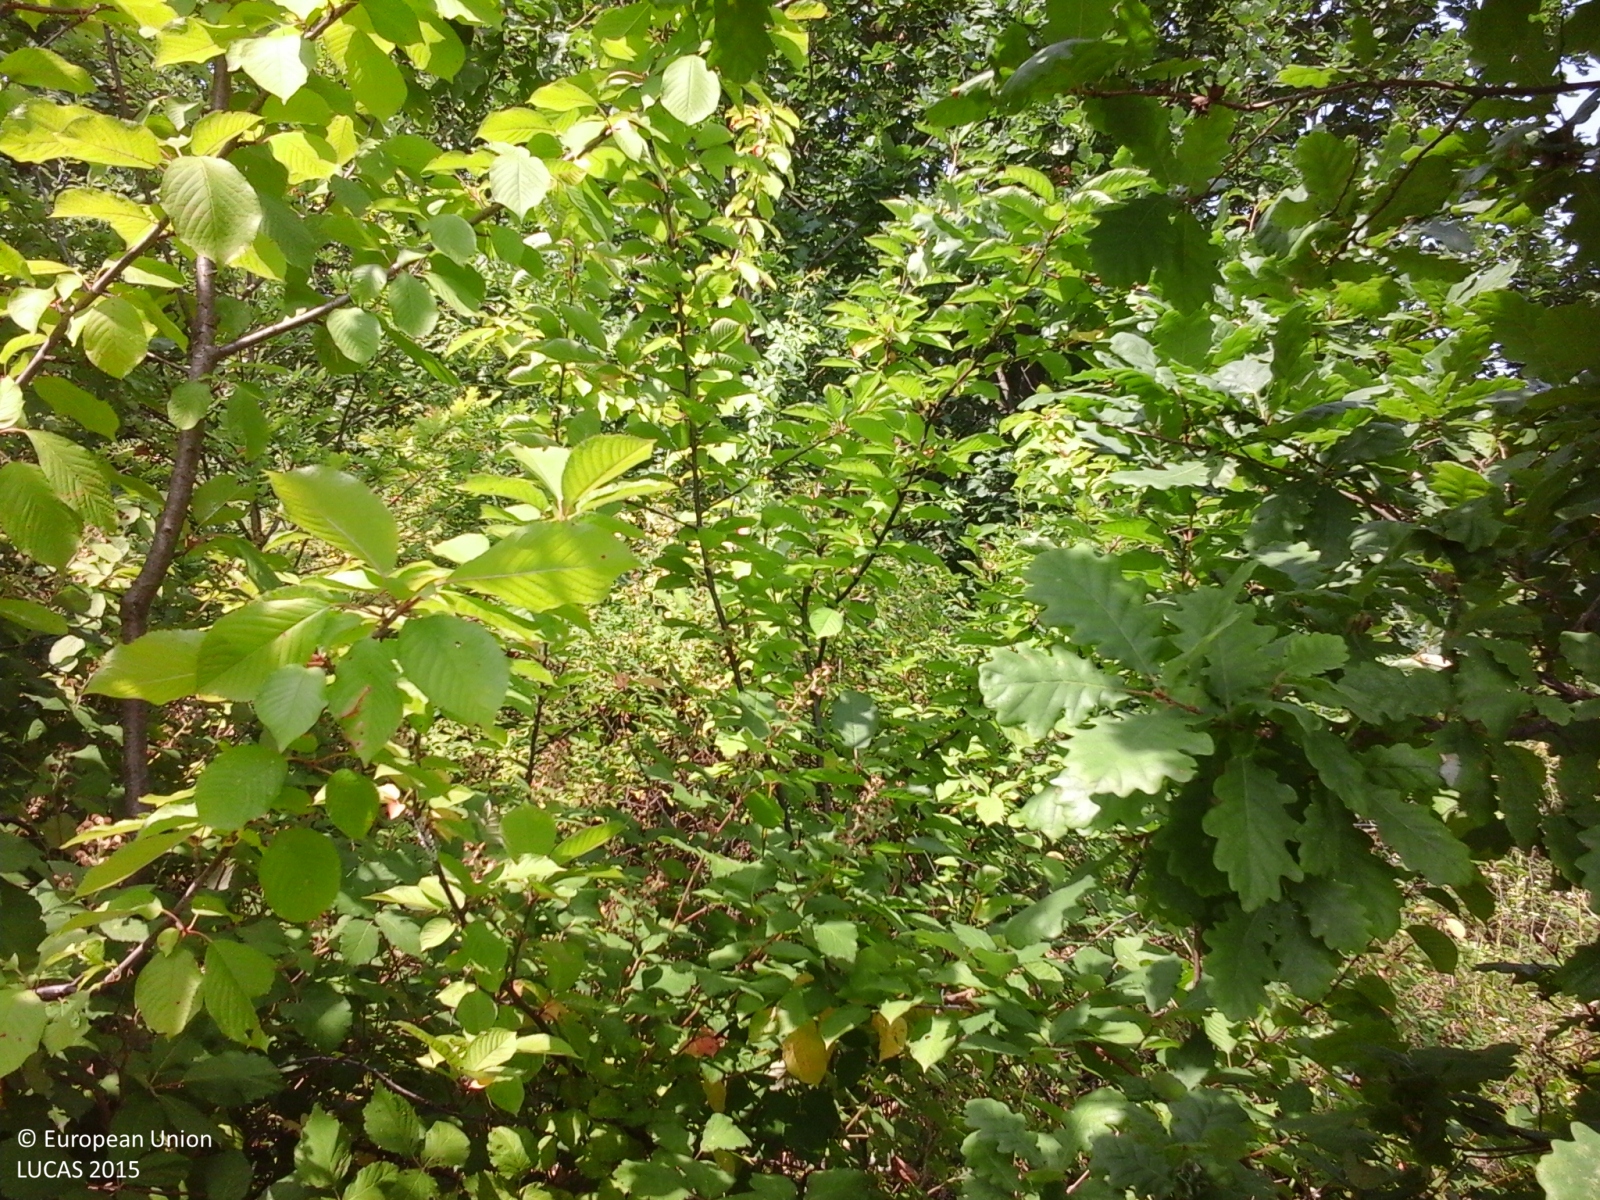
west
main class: Woodland
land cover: Broadleaved woodland
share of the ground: > 75 %
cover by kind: broadleaved forest trees 70 %, shrubs 20 %, herbaceous plants 10 %
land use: Semi-natural and natural areas not in use
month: July
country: IT
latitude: 44.7729
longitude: 8.5246
